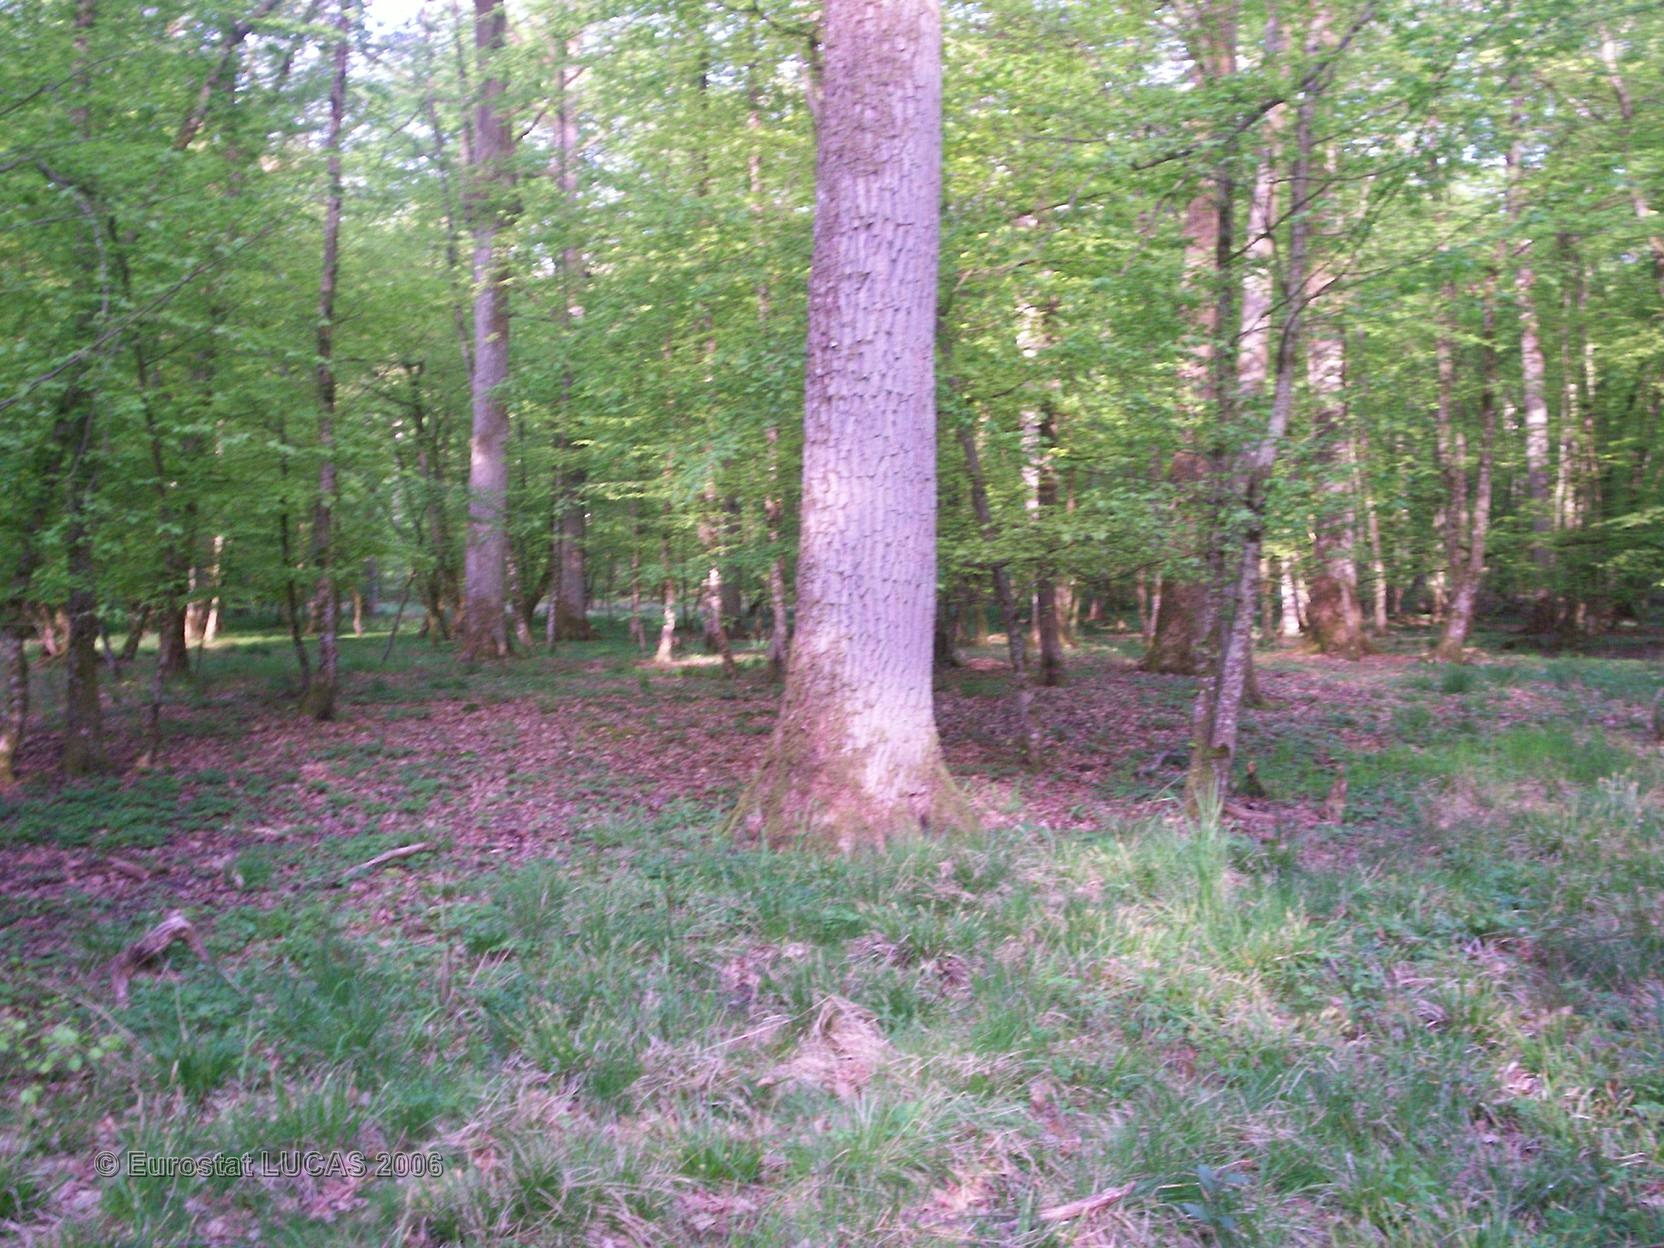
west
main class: Woodland
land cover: Broadleaved forest
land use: Forestry
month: May
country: FR
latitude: 48.9744
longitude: 6.9812
